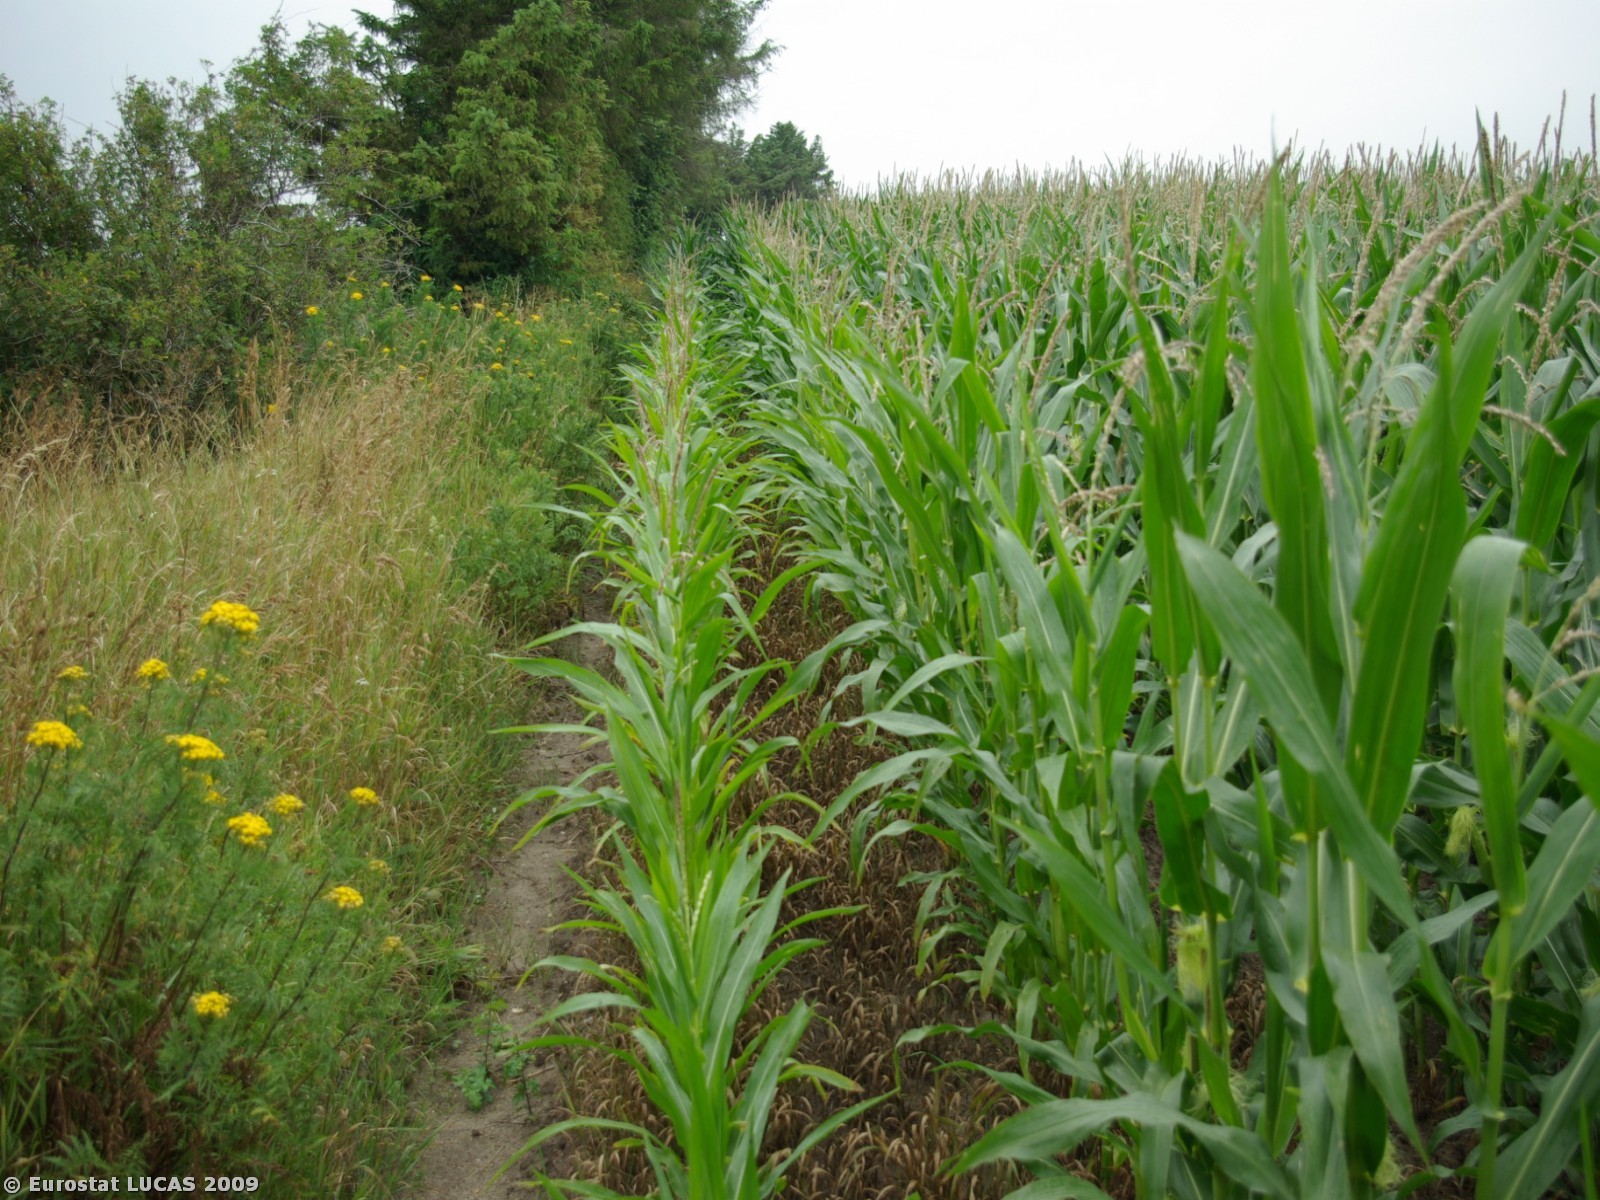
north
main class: Cropland
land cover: Maize
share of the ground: > 75 %
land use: Agriculture (excluding fallow land and kitchen gardens)
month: July
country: DK
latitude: 55.1574
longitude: 8.7925
